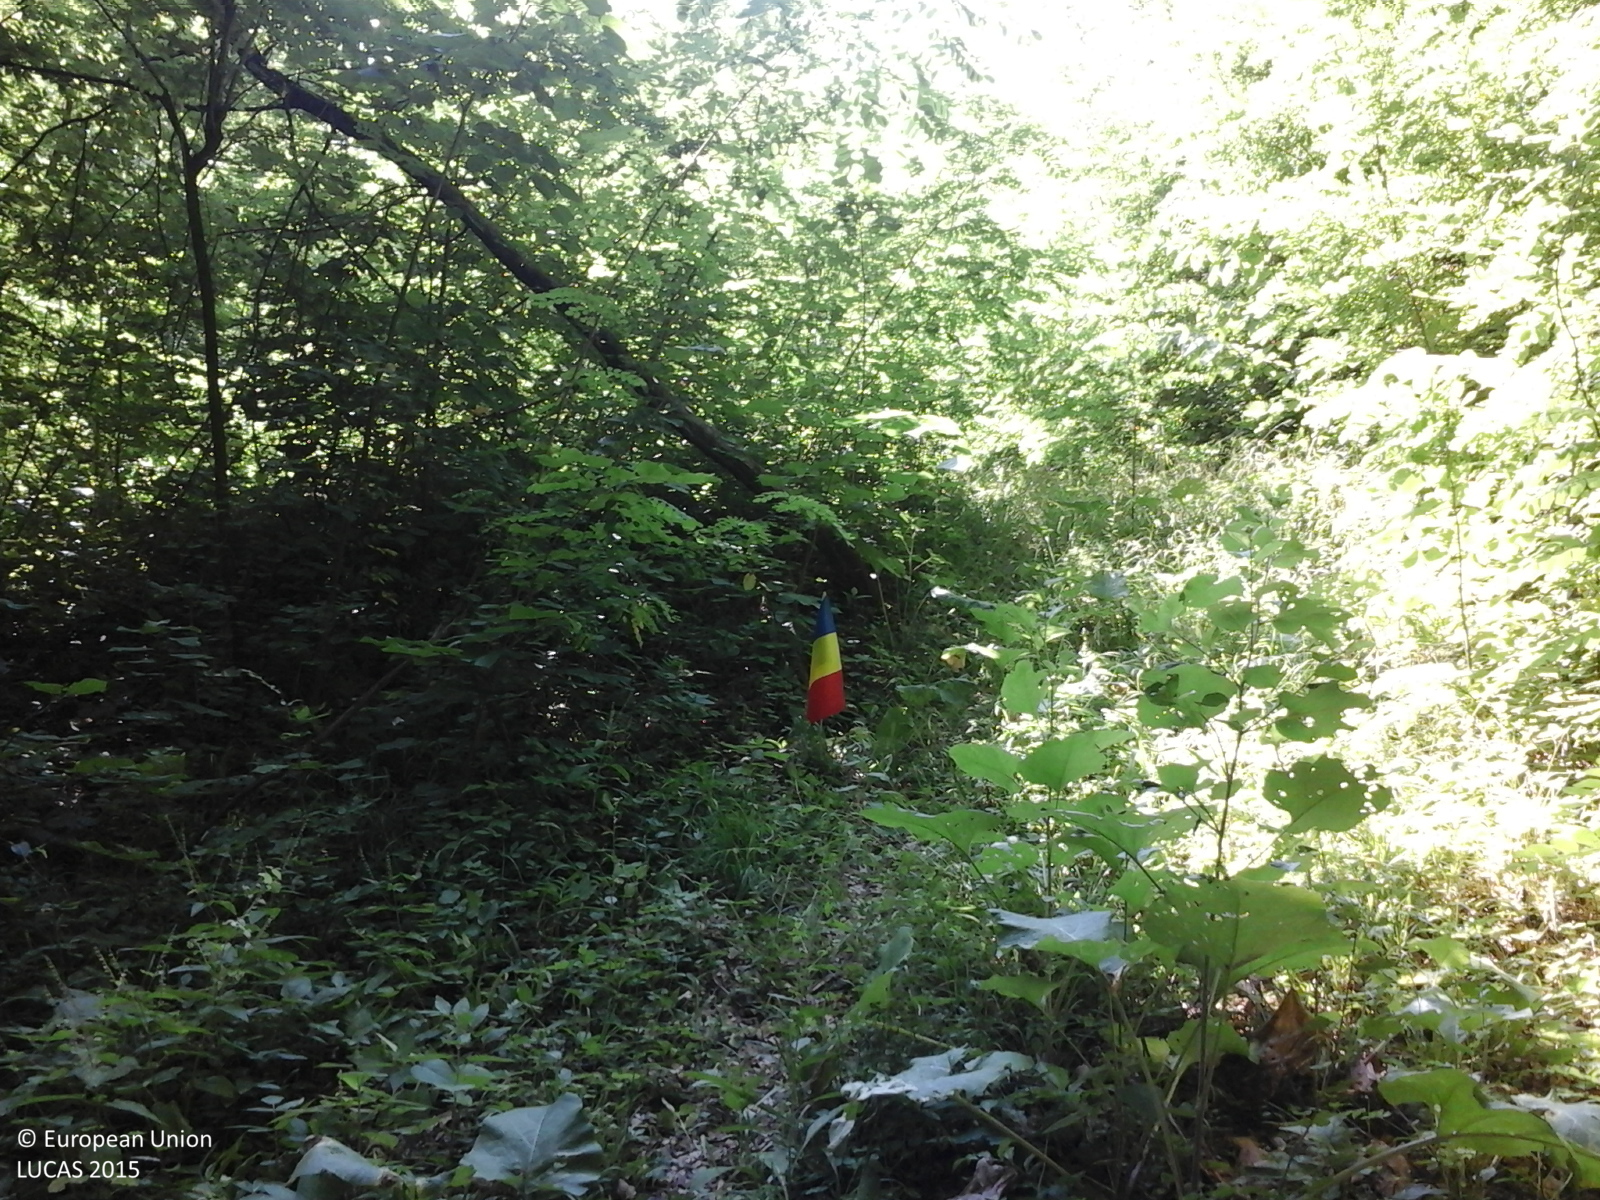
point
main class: Woodland
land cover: Broadleaved woodland
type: mesophytic deciduous forest
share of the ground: > 75 %
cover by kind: broadleaved forest trees 100 %
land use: Forestry
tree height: > 5 m
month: June
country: RO
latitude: 47.0176
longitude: 27.5743
